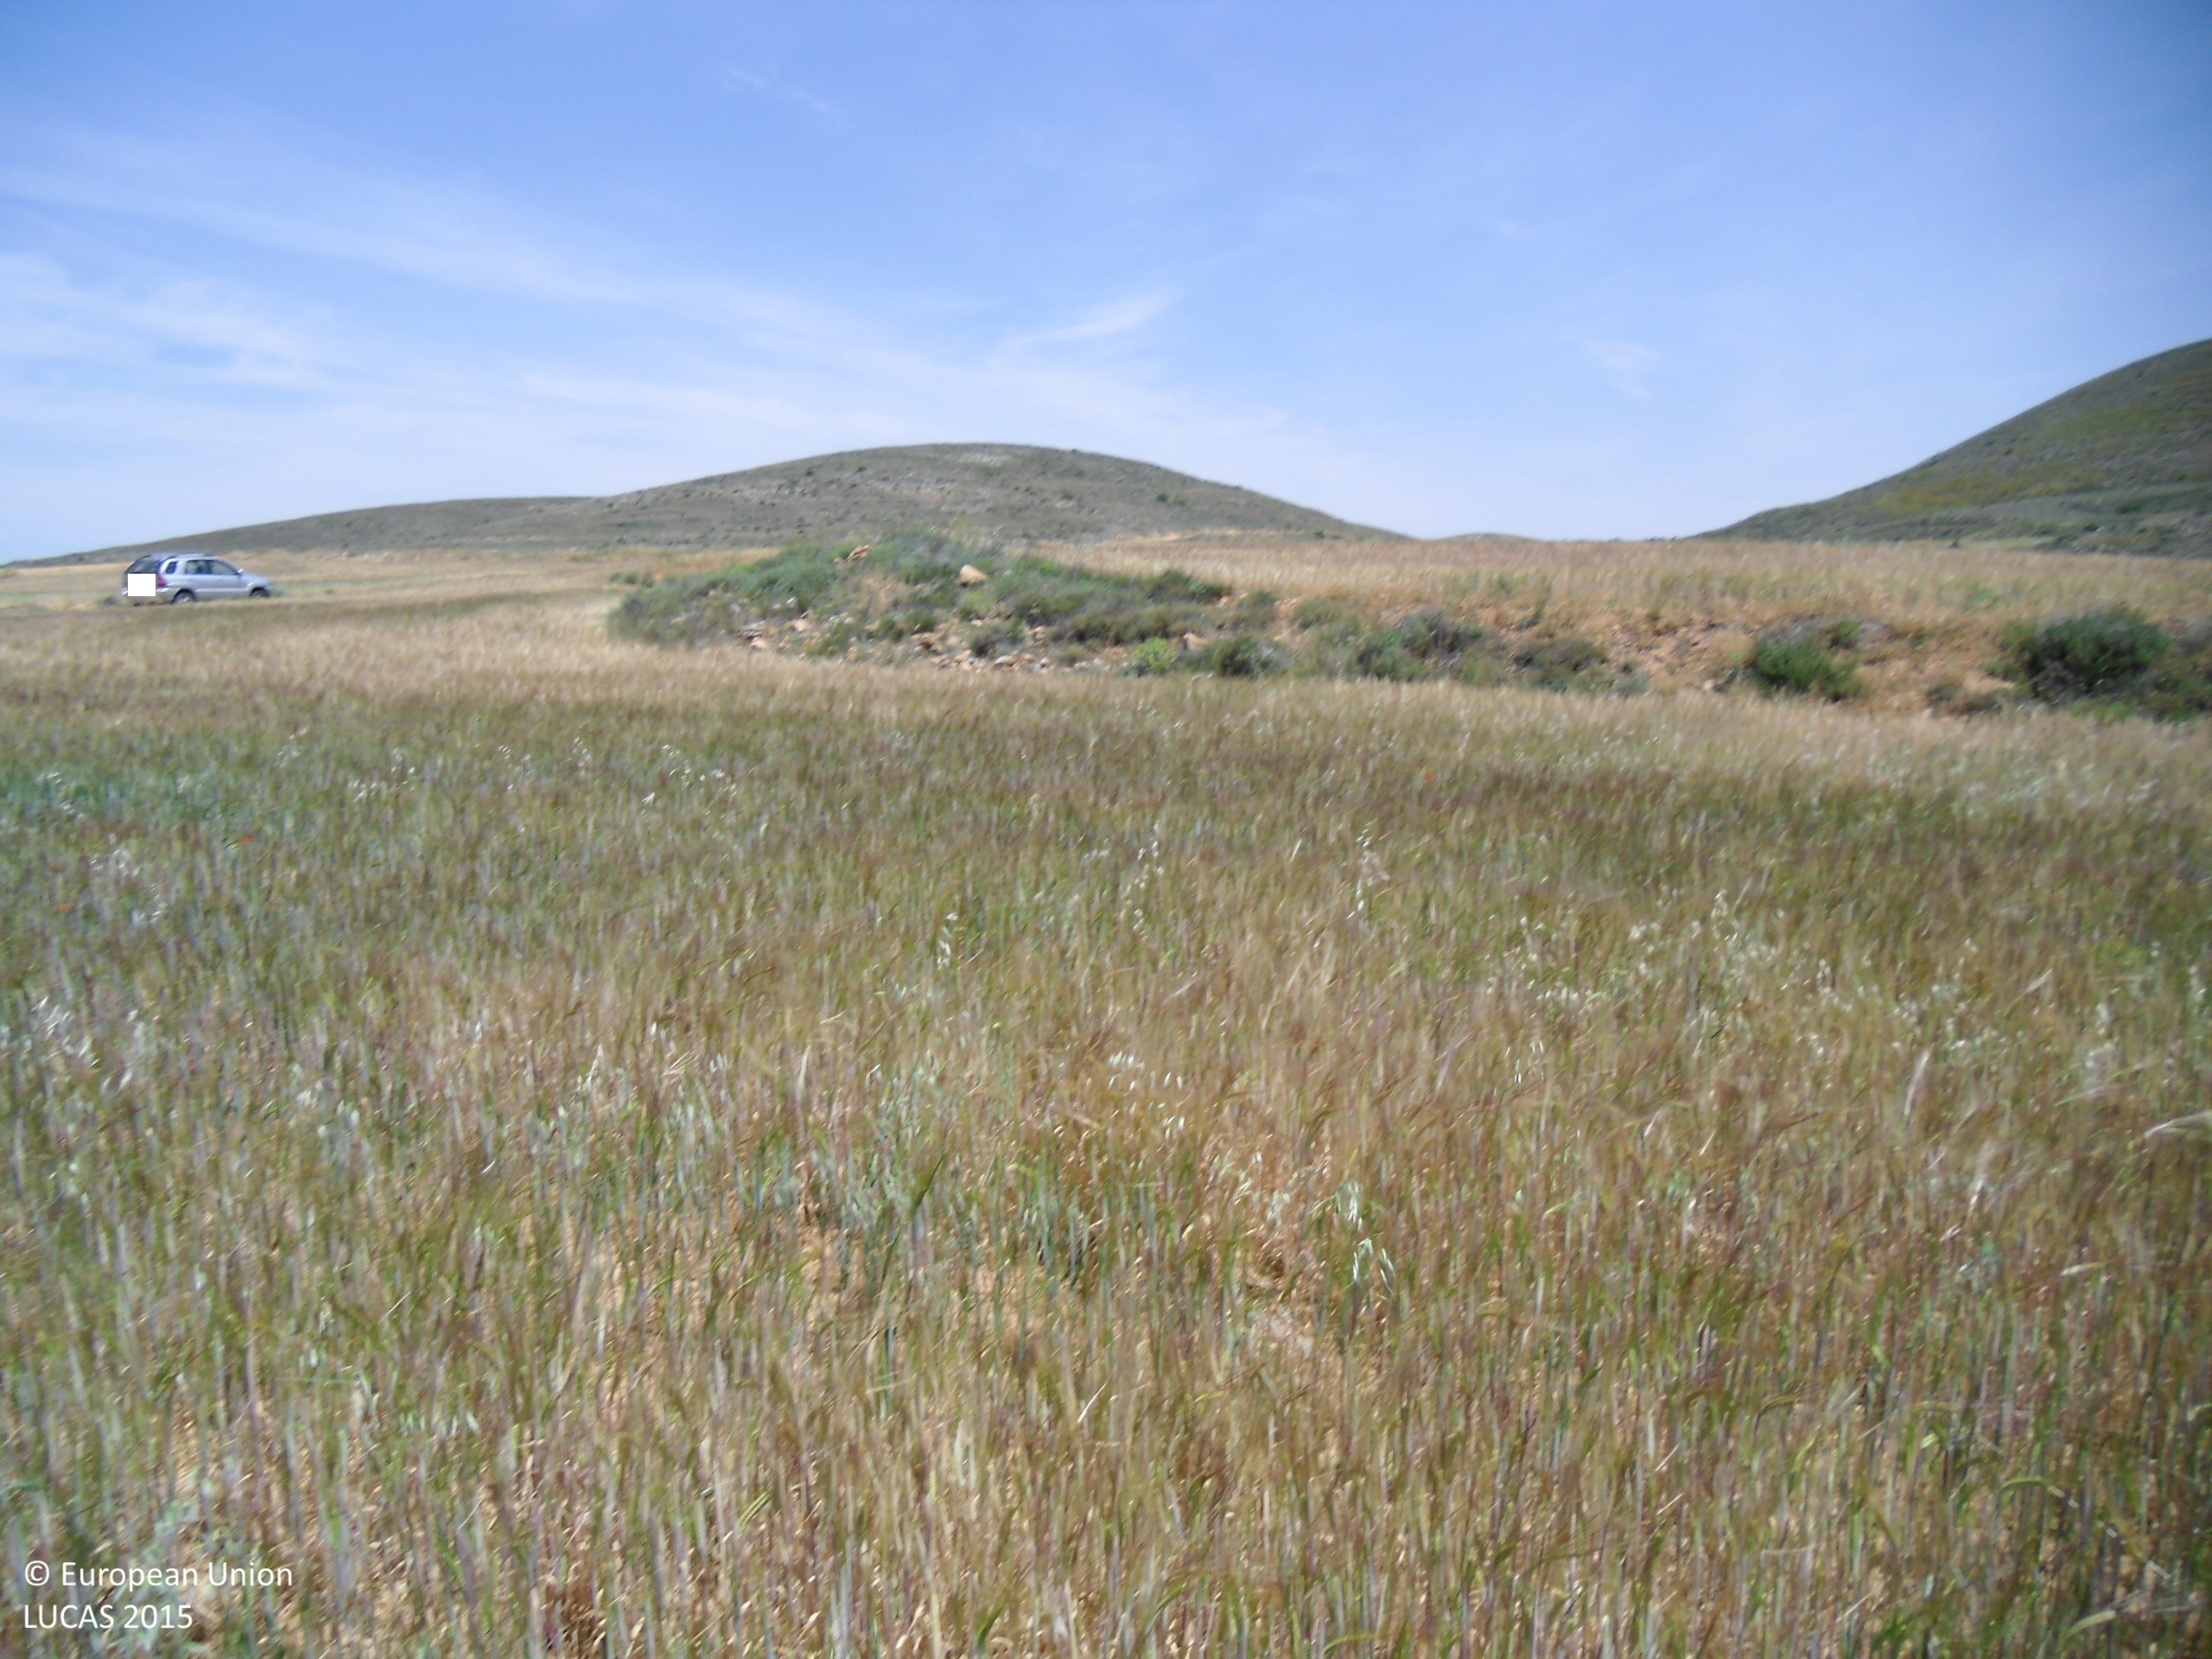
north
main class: Cropland
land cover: Barley
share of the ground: > 75 %
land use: Agriculture (excluding fallow land and kitchen gardens)
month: June
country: ES
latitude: 41.0847
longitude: -0.8606
